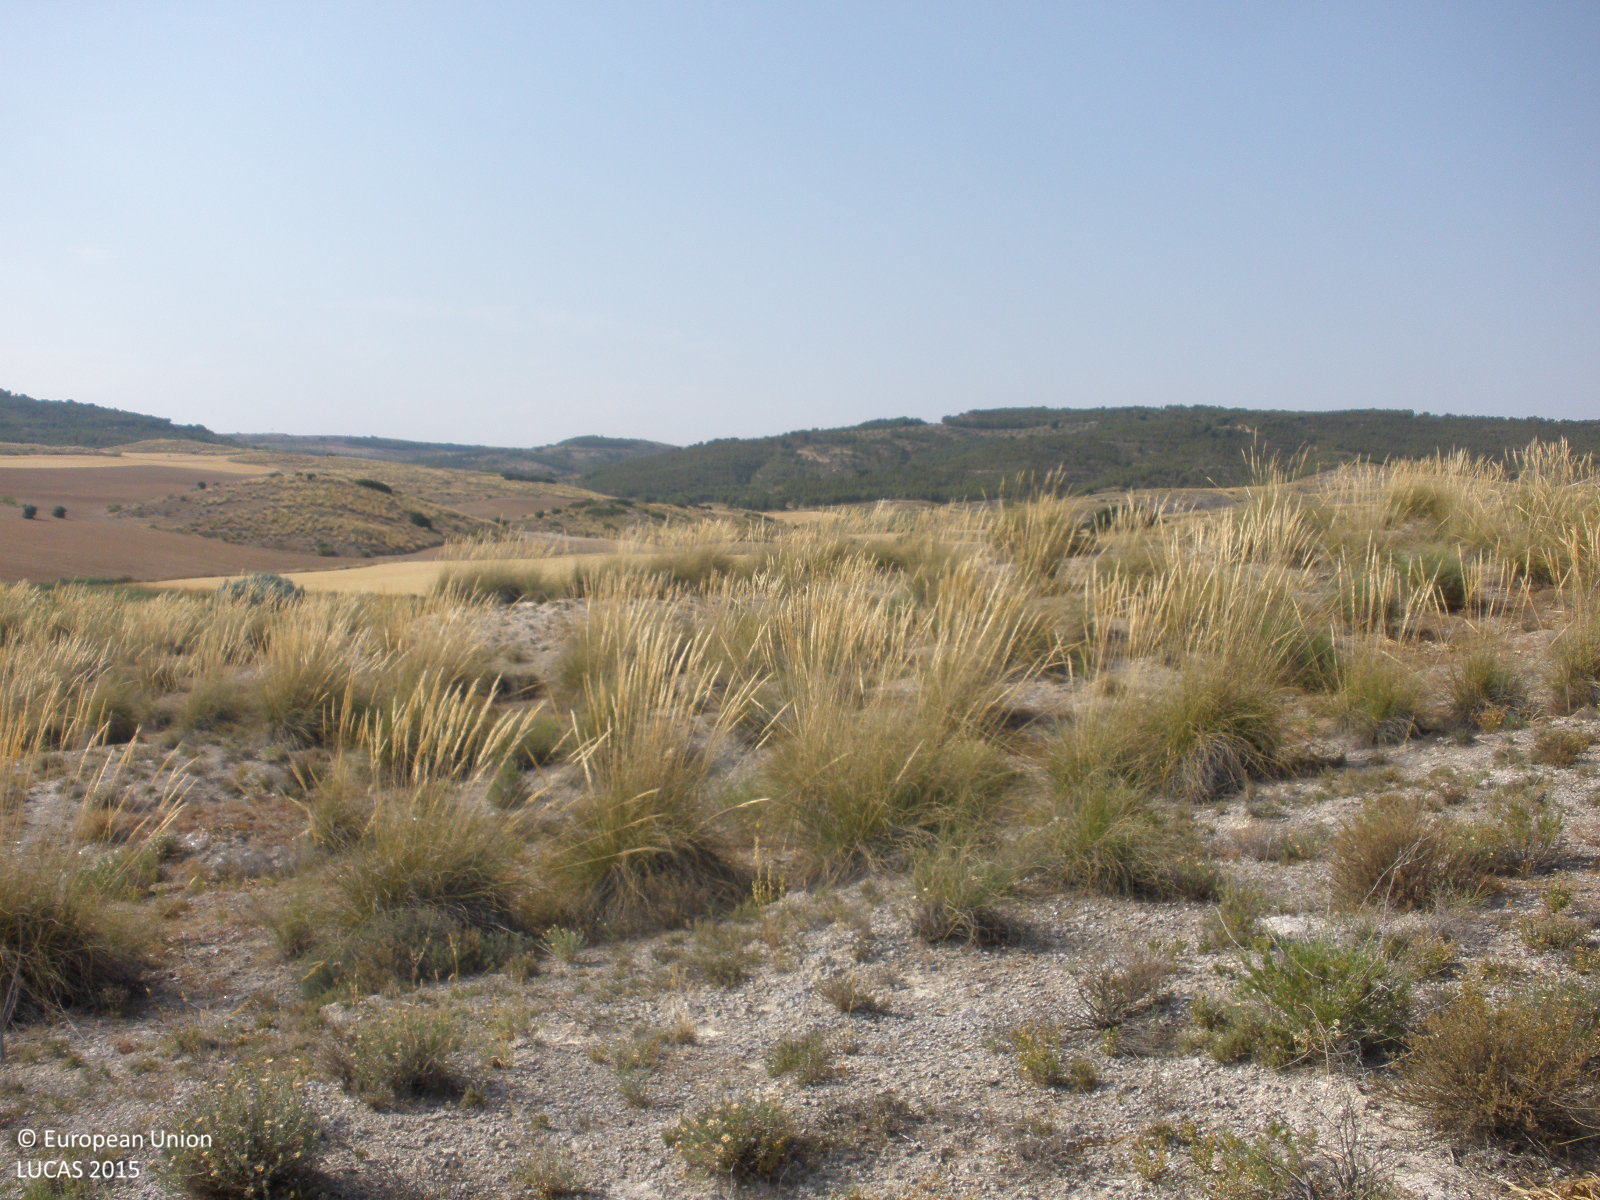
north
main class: Shrubland
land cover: Shrubland without tree cover
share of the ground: 25 - 50 %
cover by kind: shrubs 40 %, herbaceous plants 30 %, consolidated bare surface 30 %
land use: Semi-natural and natural areas not in use
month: July
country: ES
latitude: 40.0633
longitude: -3.3589
